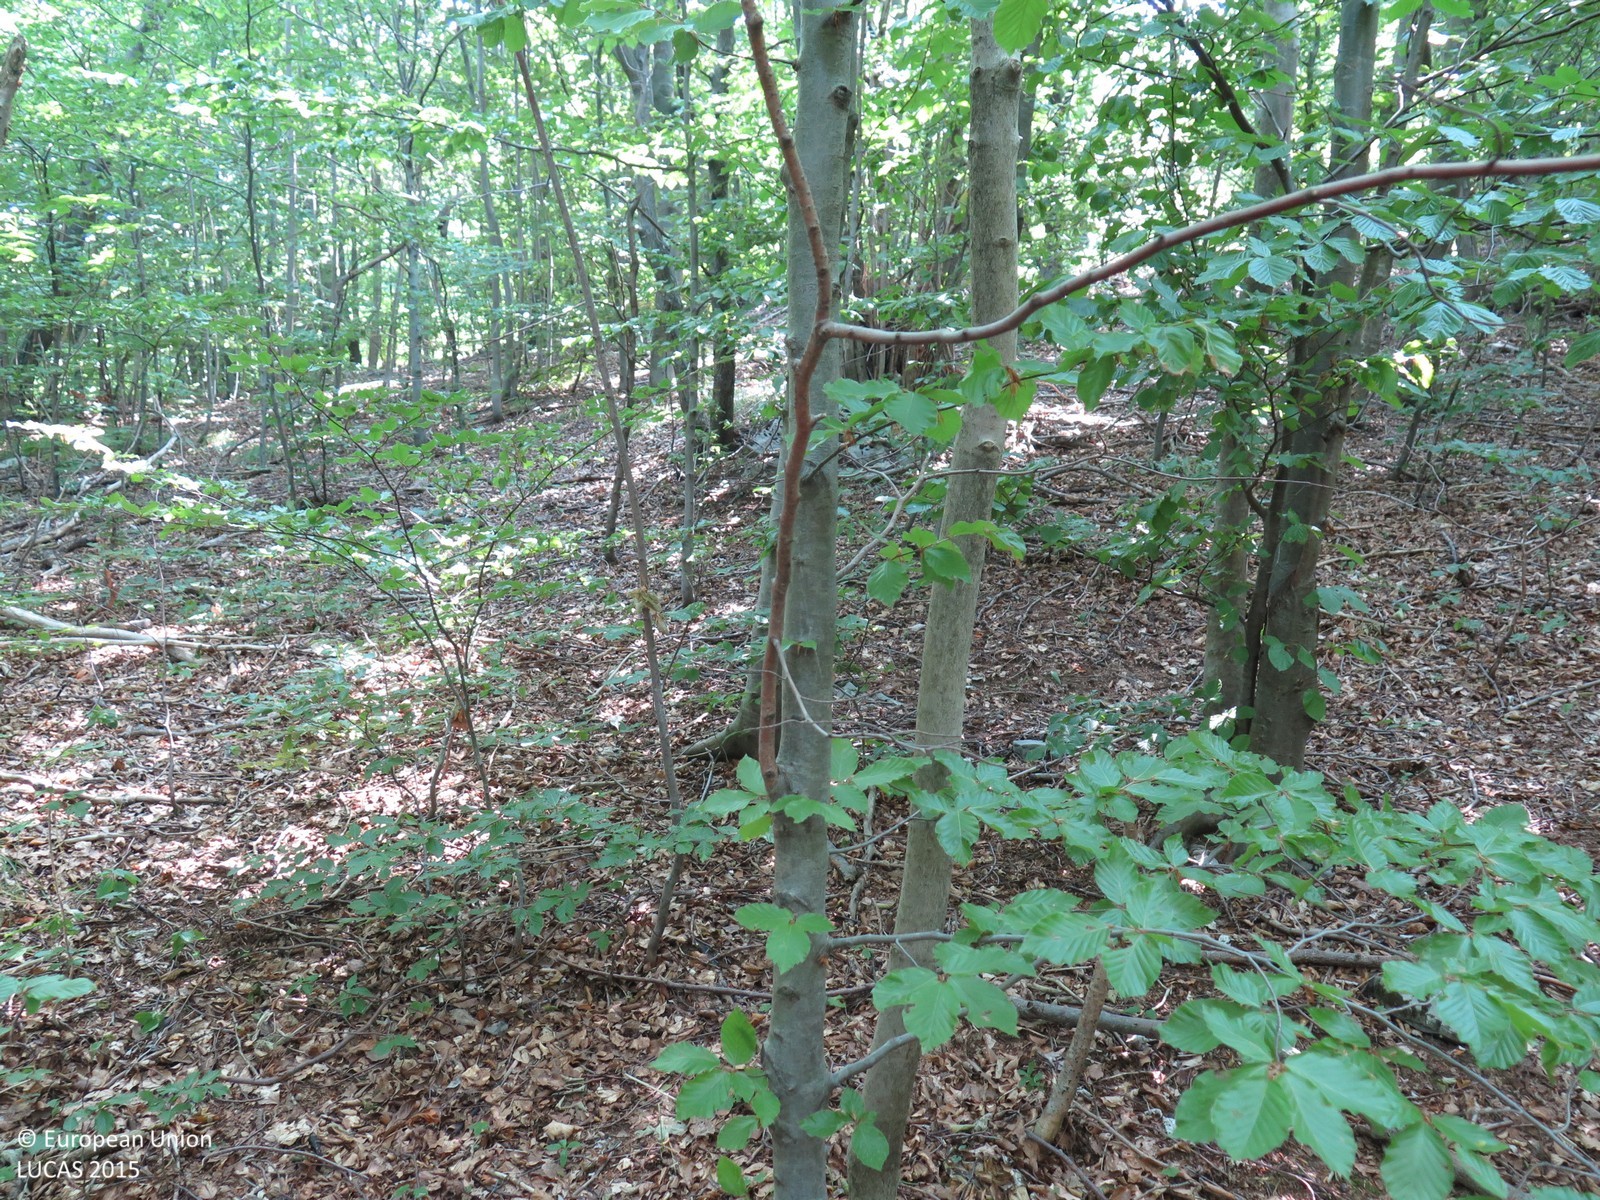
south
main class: Woodland
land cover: Broadleaved woodland
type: beech forest
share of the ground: > 75 %
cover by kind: broadleaved forest trees 90 %, herbaceous plants 5 %, unconsolidated bare surface 5 %
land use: Forestry
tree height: > 5 m
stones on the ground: 10 - 25 %
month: August
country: HR
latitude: 45.3679
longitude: 14.6043
